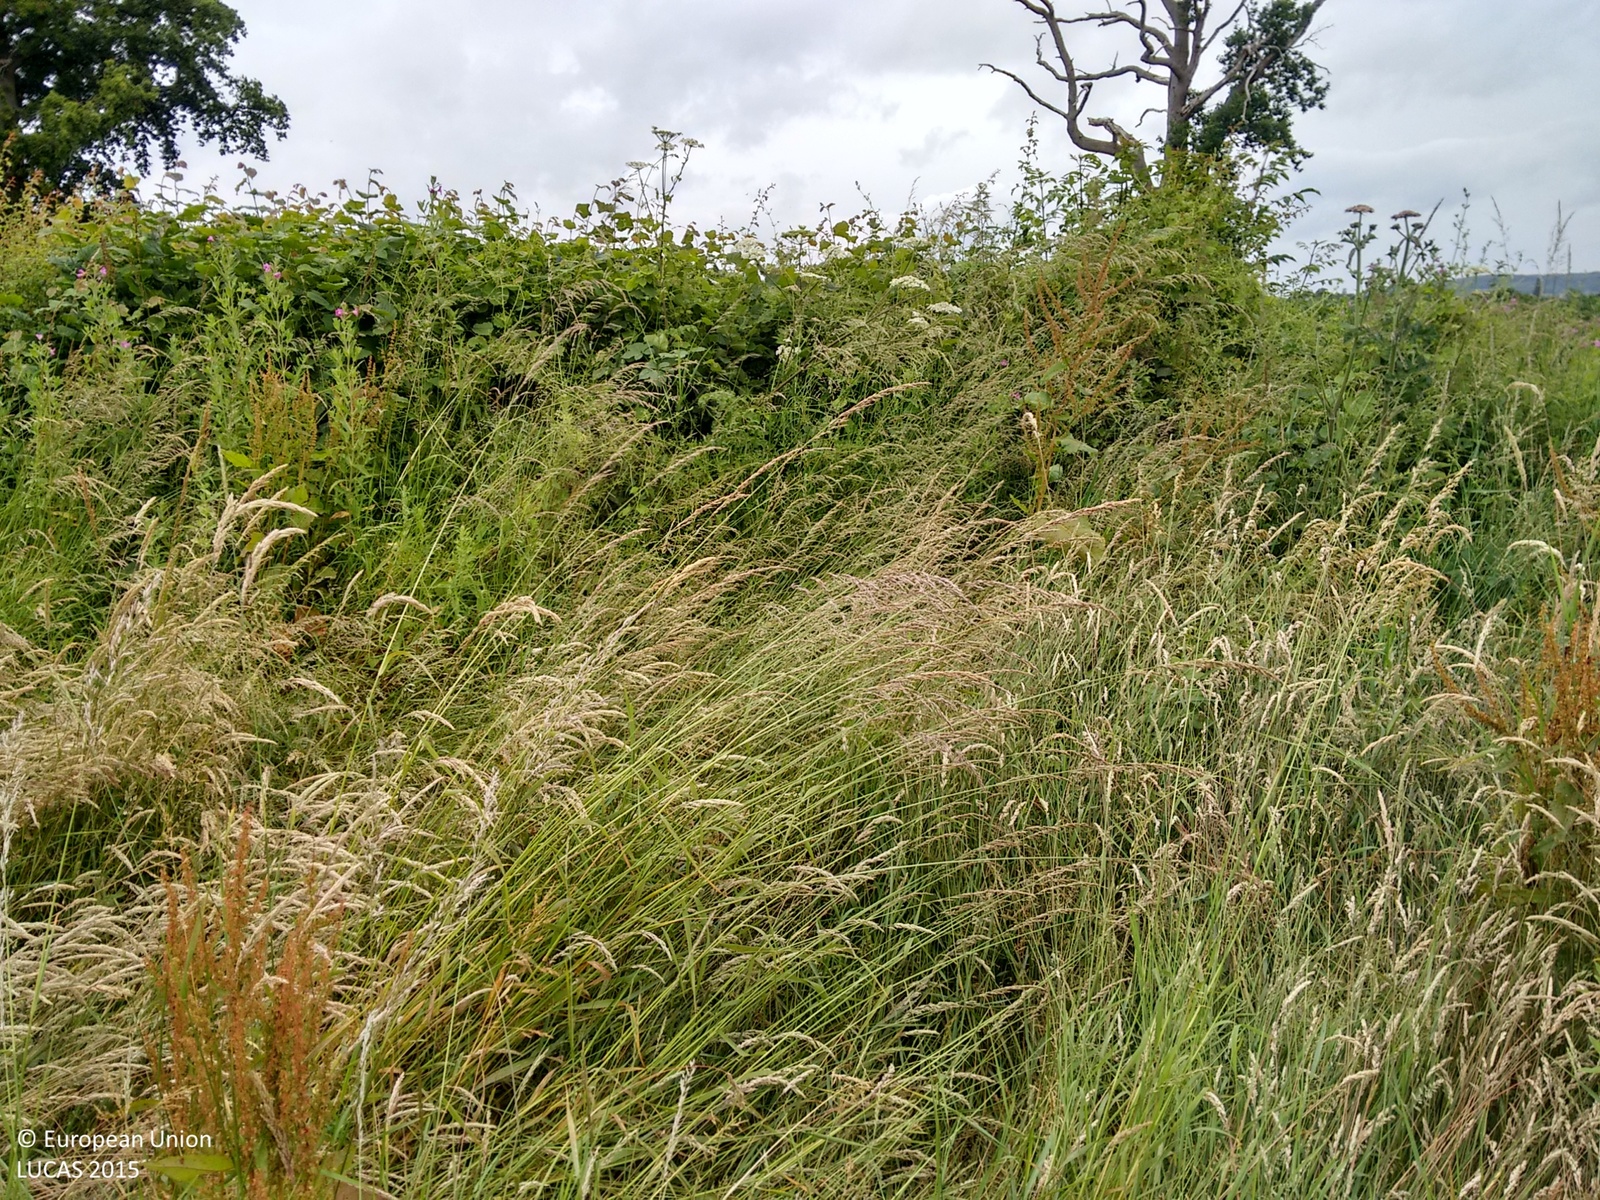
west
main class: Cropland
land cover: Rape and turnip rape
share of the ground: > 75 %
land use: Agriculture (excluding fallow land and kitchen gardens)
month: July
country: GB
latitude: 52.0555
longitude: -2.5363
